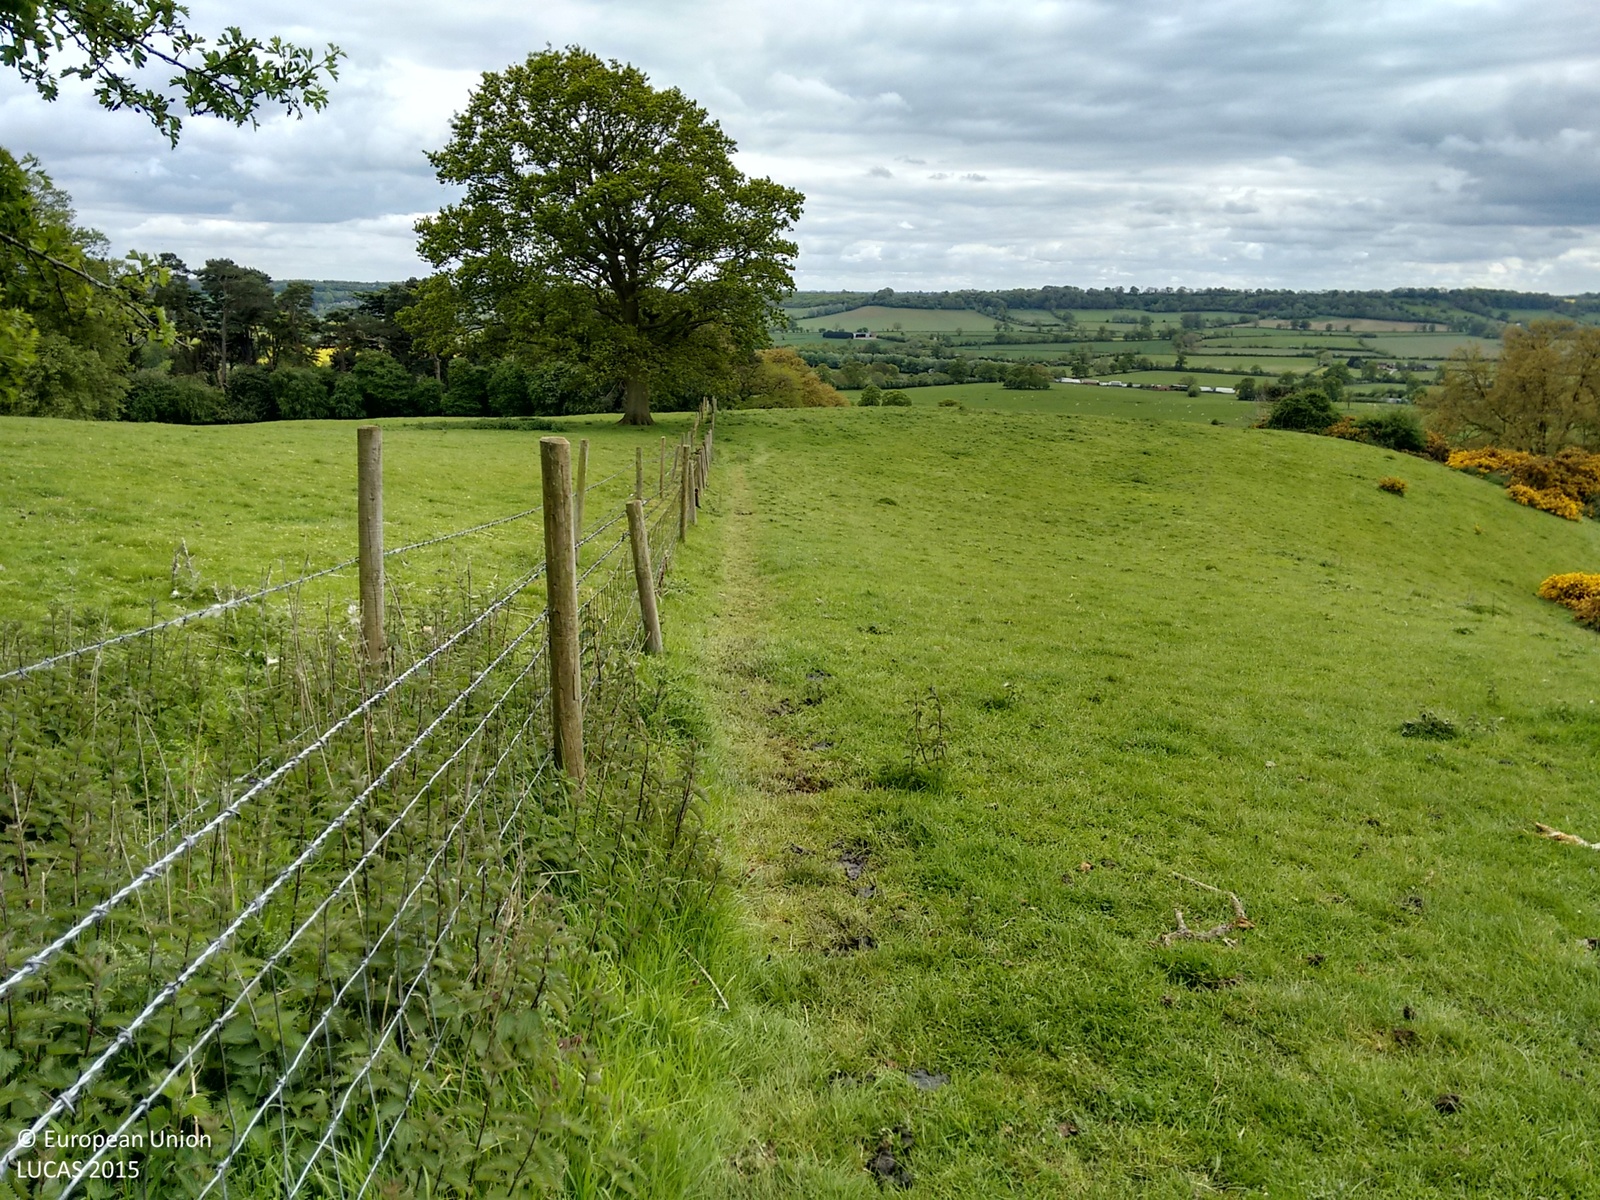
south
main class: Grassland
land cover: Grassland without tree/shrub cover
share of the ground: > 75 %
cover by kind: herbaceous plants 100 %
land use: Agriculture (excluding fallow land and kitchen gardens)
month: May
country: GB
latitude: 52.1526
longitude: -1.4061
